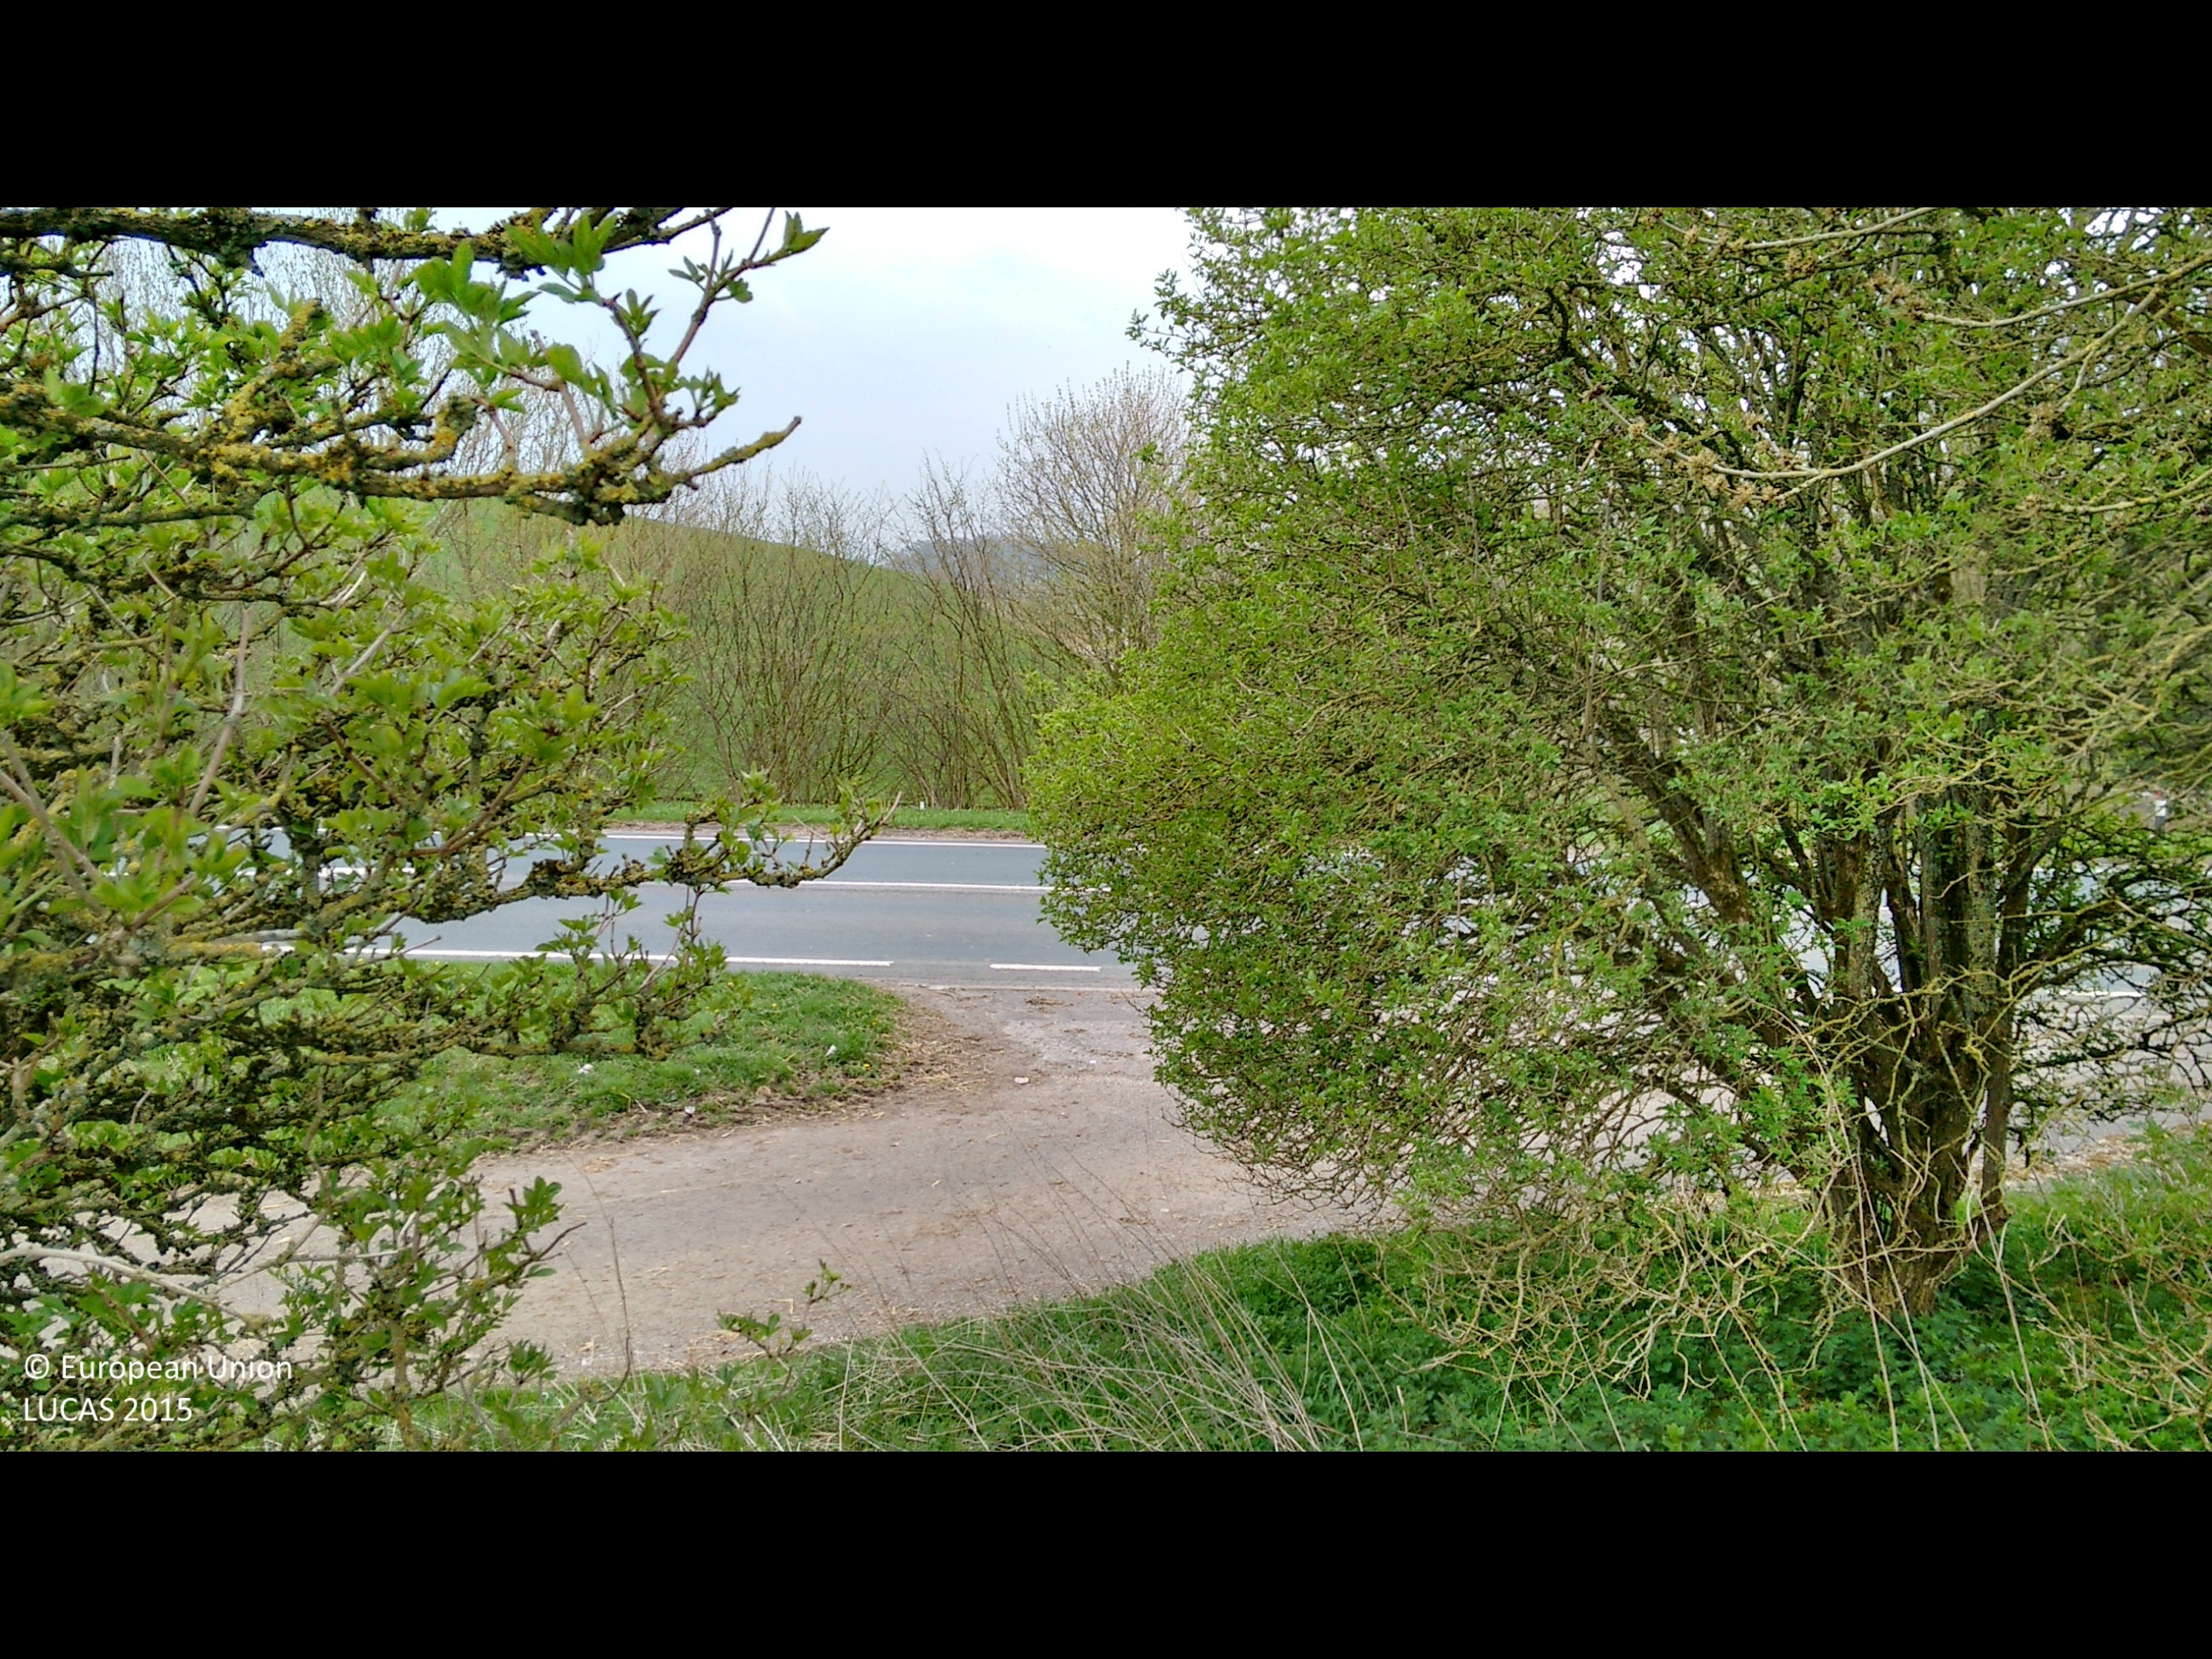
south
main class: Grassland
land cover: Grassland without tree/shrub cover
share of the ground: > 75 %
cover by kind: herbaceous plants 100 %
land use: Agriculture (excluding fallow land and kitchen gardens)
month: April
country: GB
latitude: 53.9464
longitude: -2.2031
